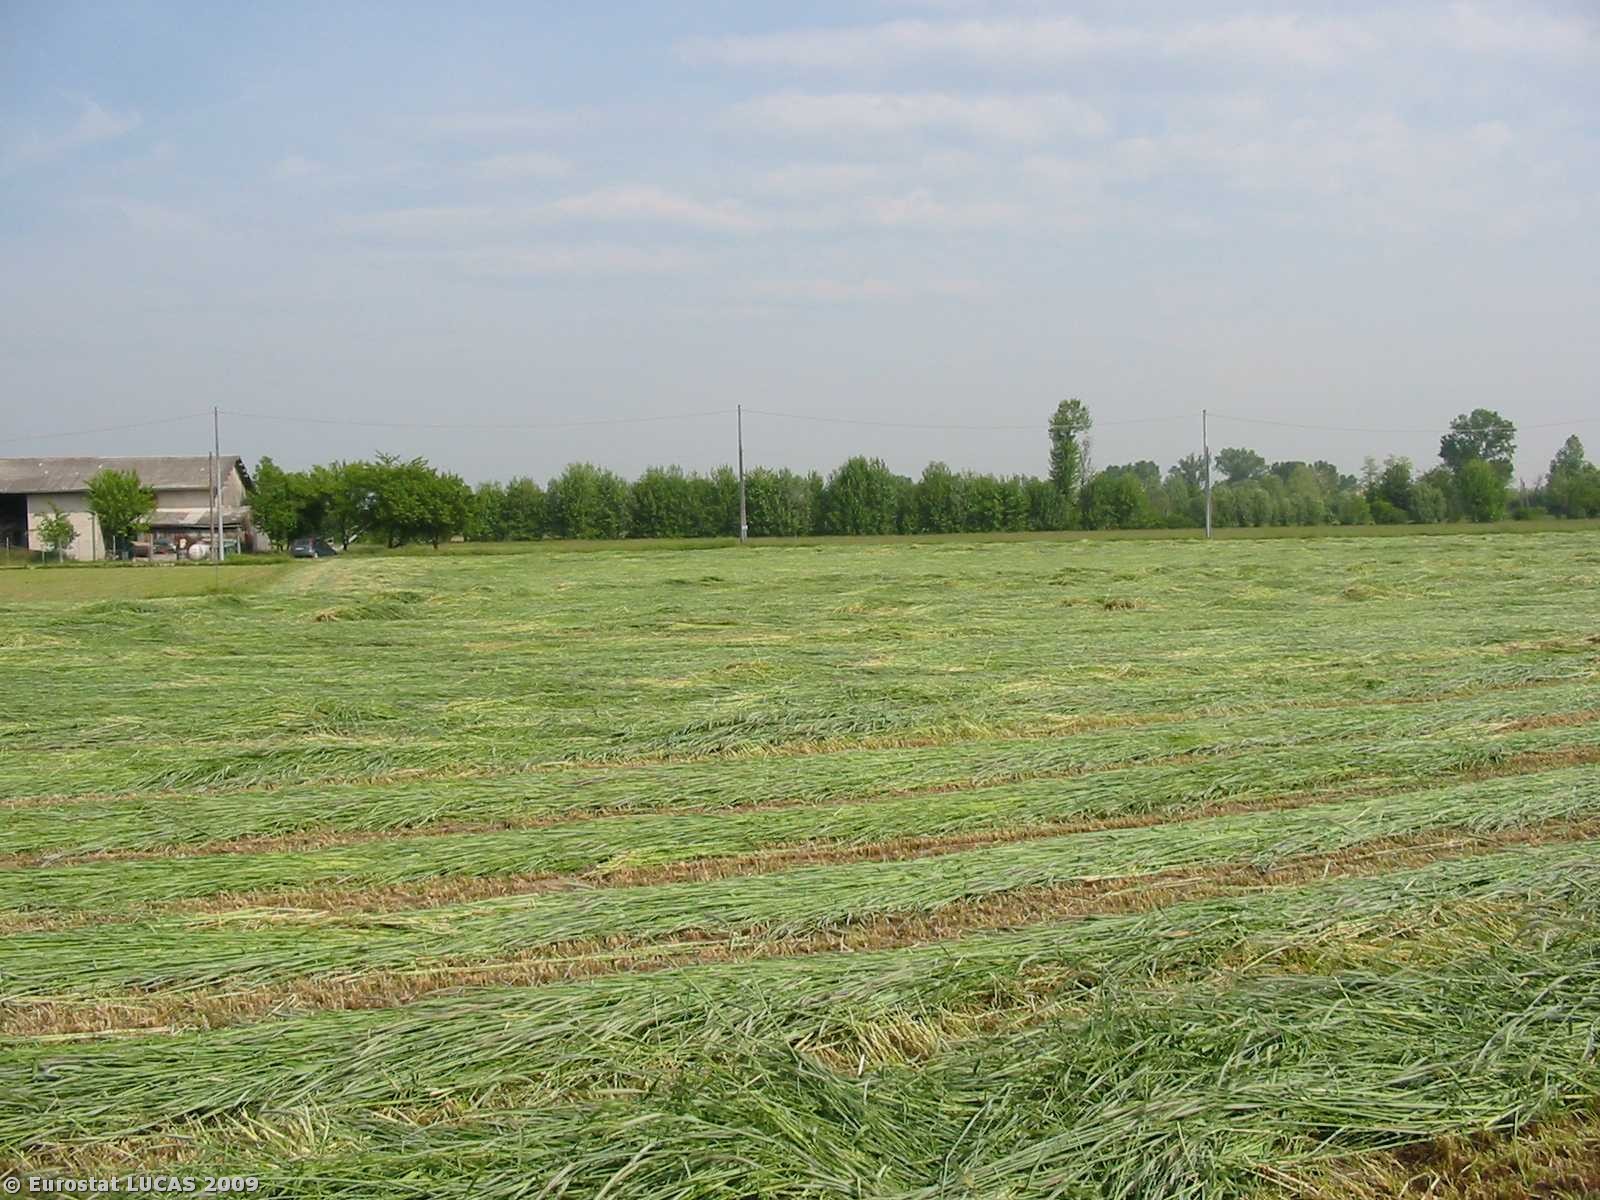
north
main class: Cropland
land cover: Rye
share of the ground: < 10 %
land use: Agriculture (excluding fallow land and kitchen gardens)
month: May
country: IT
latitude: 45.5083
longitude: 11.7251
